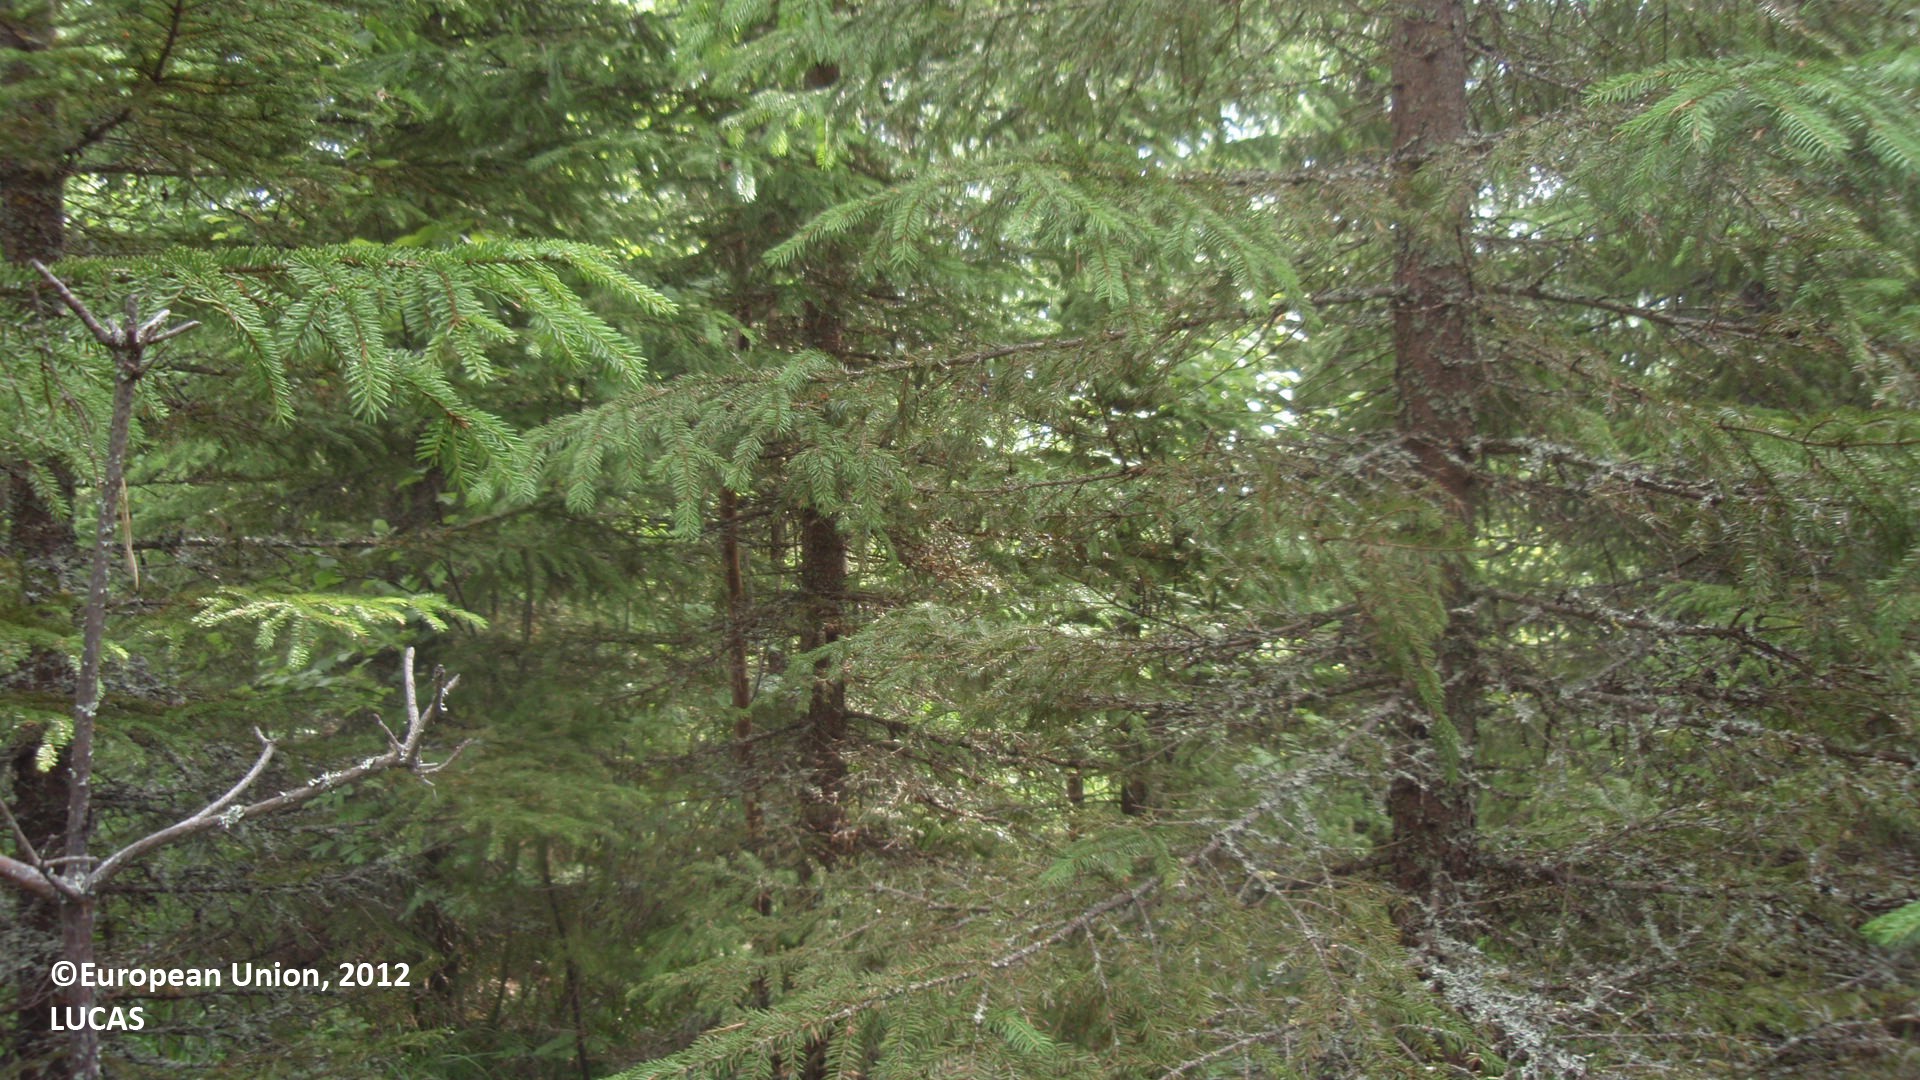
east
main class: Woodland
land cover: Spruce dominated coniferous woodland
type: boreal forest
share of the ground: 25 - 50 %
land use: Forestry
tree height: > 5 m
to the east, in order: Spruce dominated coniferous woodland; Ditches and canals; Grass margins; Paved roads, cycling and walking lanes; Grass margins; Grassland with sparse tree/shrub cover; Spruce dominated mixed woodland; Spruce dominated coniferous woodland; Pine dominated coniferous woodland; Inland marshes; Inland water bodies; Pine dominated coniferous woodland
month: July
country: FI
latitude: 61.4955
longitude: 28.9958
